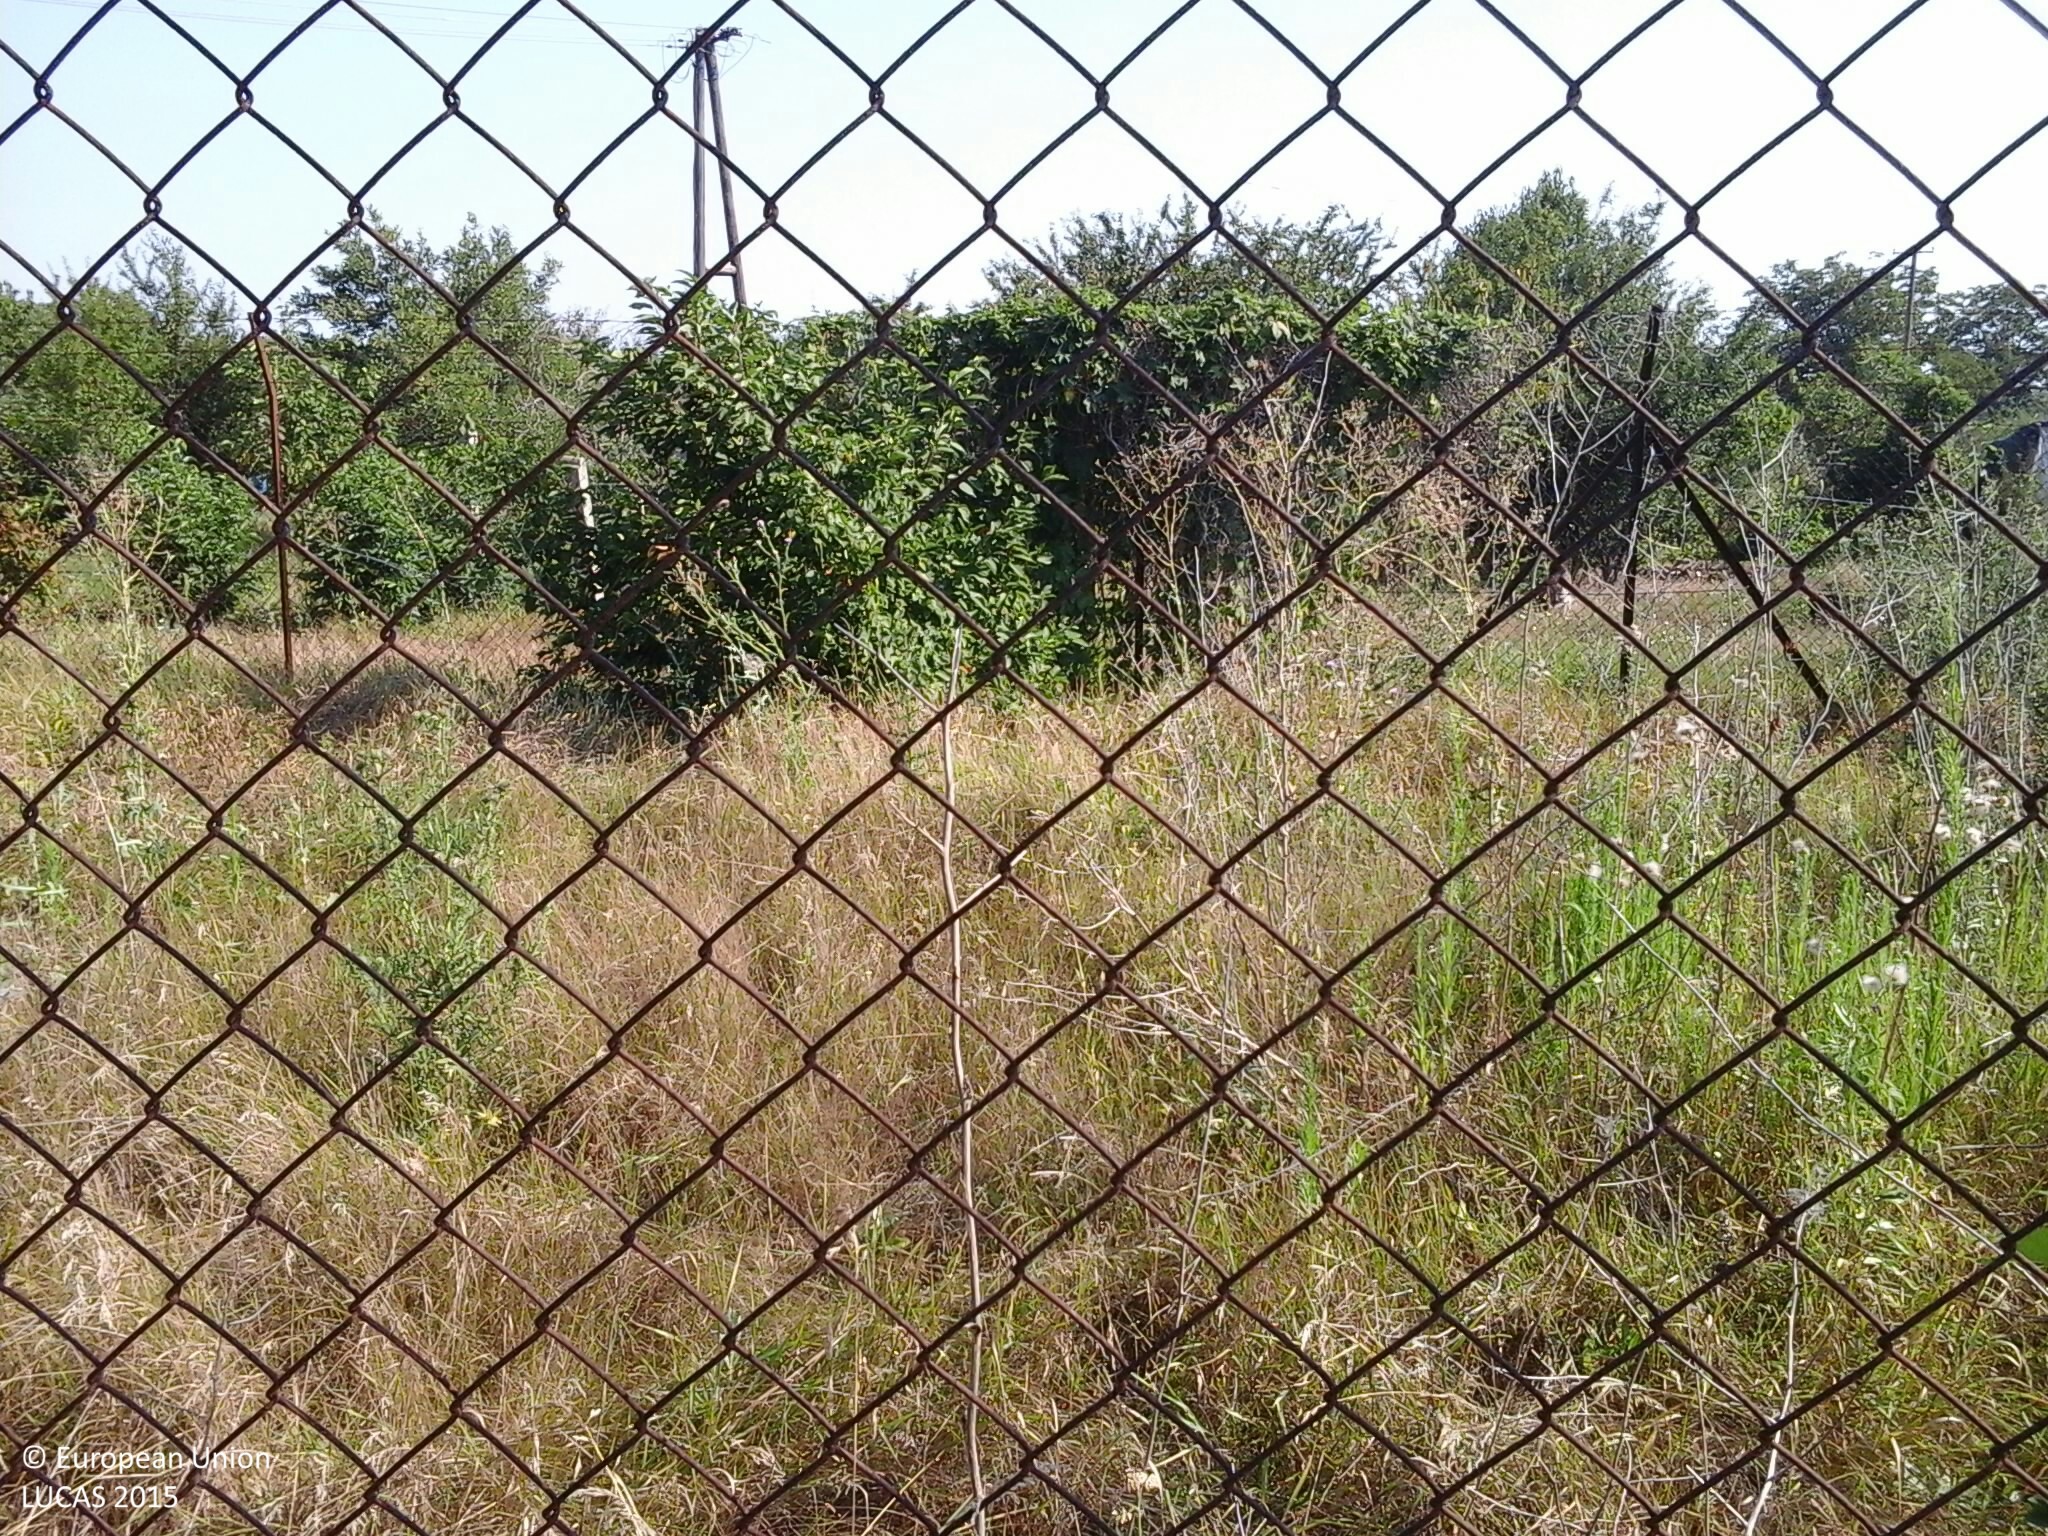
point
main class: Grassland
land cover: Grassland without tree/shrub cover
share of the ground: > 75 %
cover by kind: herbaceous plants 100 %
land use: Residential
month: July
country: HU
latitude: 47.5802
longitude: 21.3557
